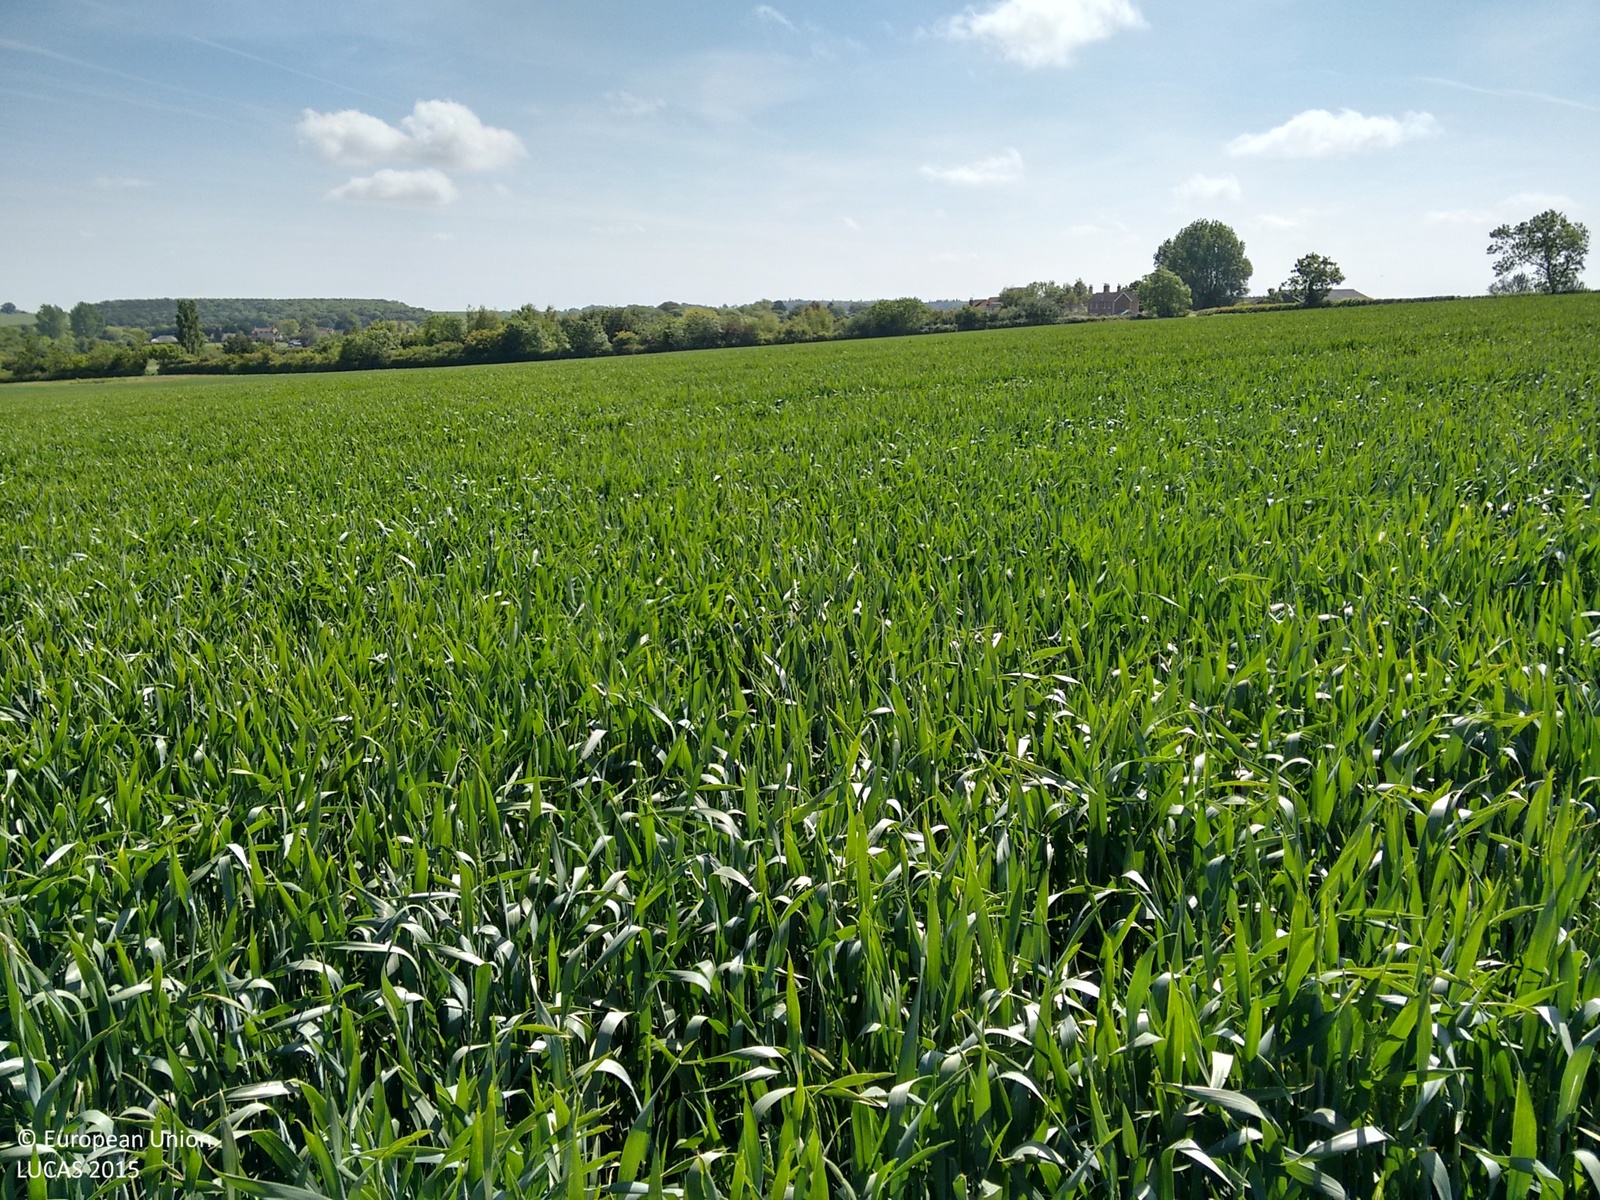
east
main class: Cropland
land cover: Common wheat
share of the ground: > 75 %
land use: Agriculture (excluding fallow land and kitchen gardens)
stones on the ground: 10 - 25 %
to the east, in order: Common wheat; Grass margins; Tracks; Grass margins; Managed hedges; Ditches and canals; Grassland with sparse tree/shrub cover
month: June
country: GB
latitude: 52.8654
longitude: -0.5704
